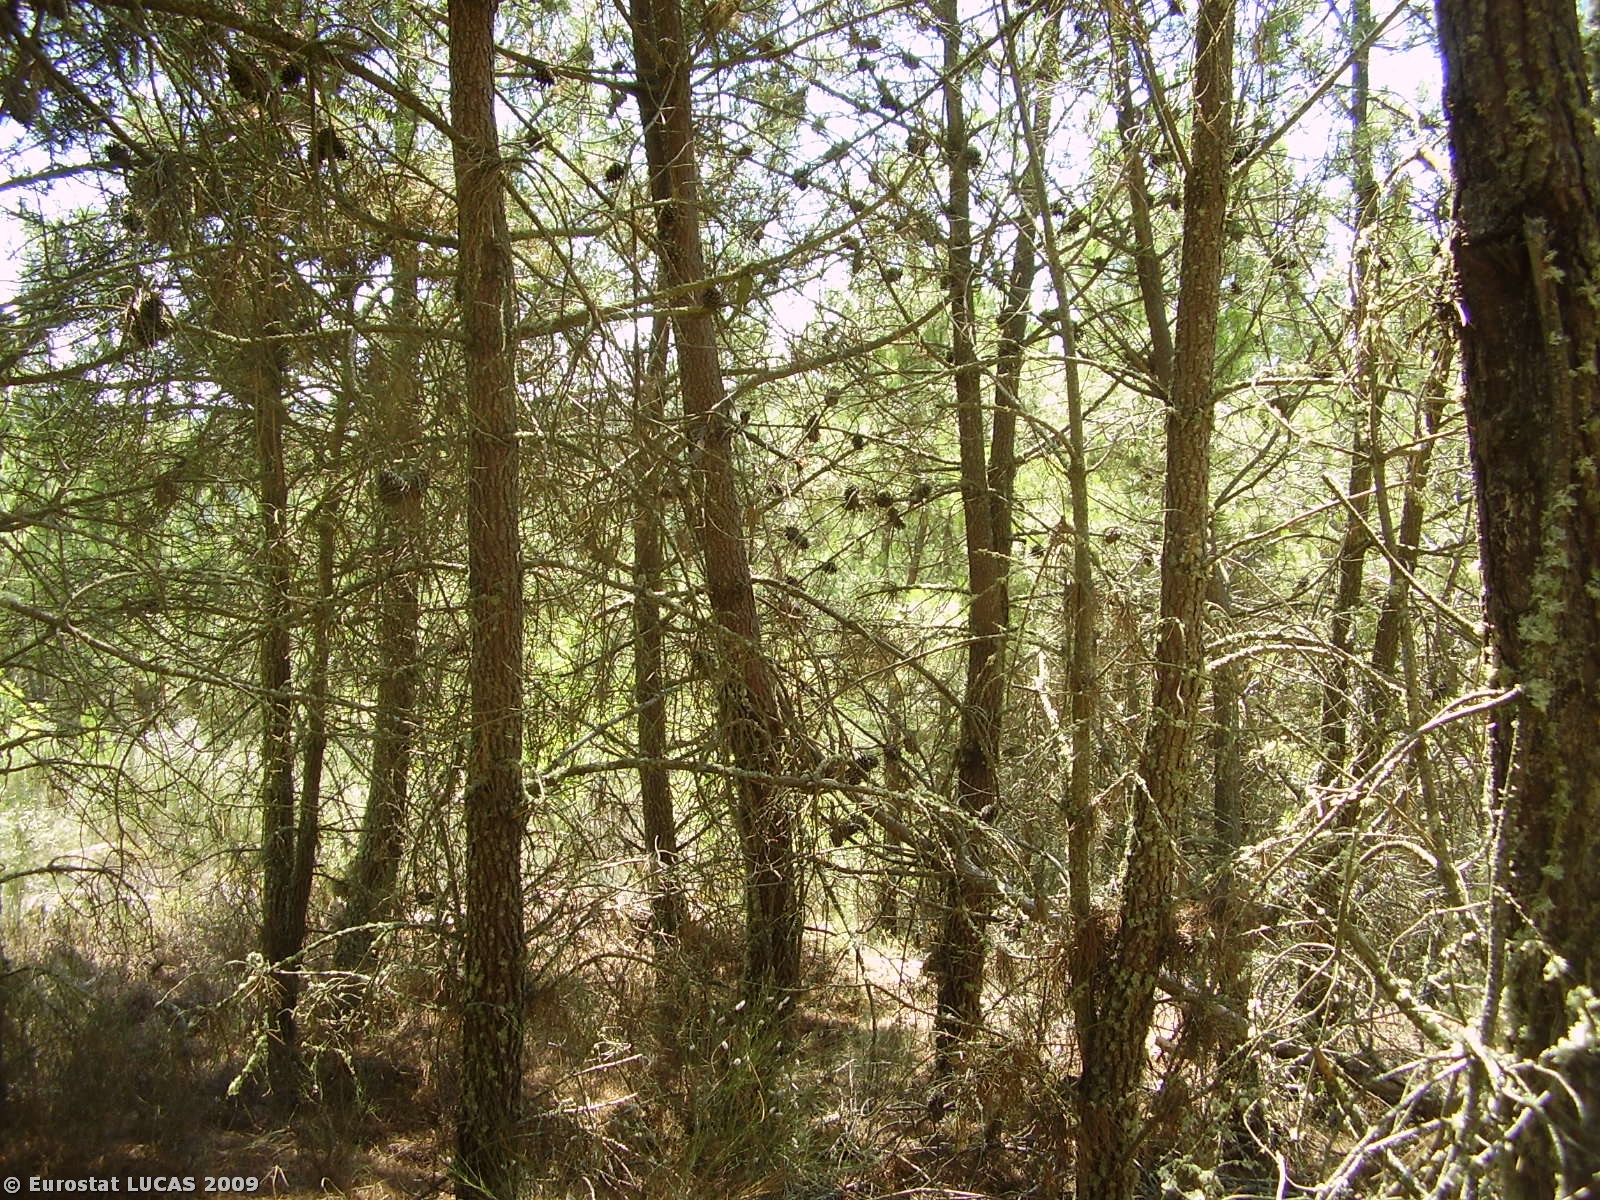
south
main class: Woodland
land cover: Coniferous woodland
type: coniferous forest of the mediterranean region
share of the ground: 10 - 25 %
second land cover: Bare land
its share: > 75 %
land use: Forestry
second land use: Fallow land
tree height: > 5 m
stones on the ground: > 50 %
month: August
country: PT
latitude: 41.2081
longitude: -6.7652
